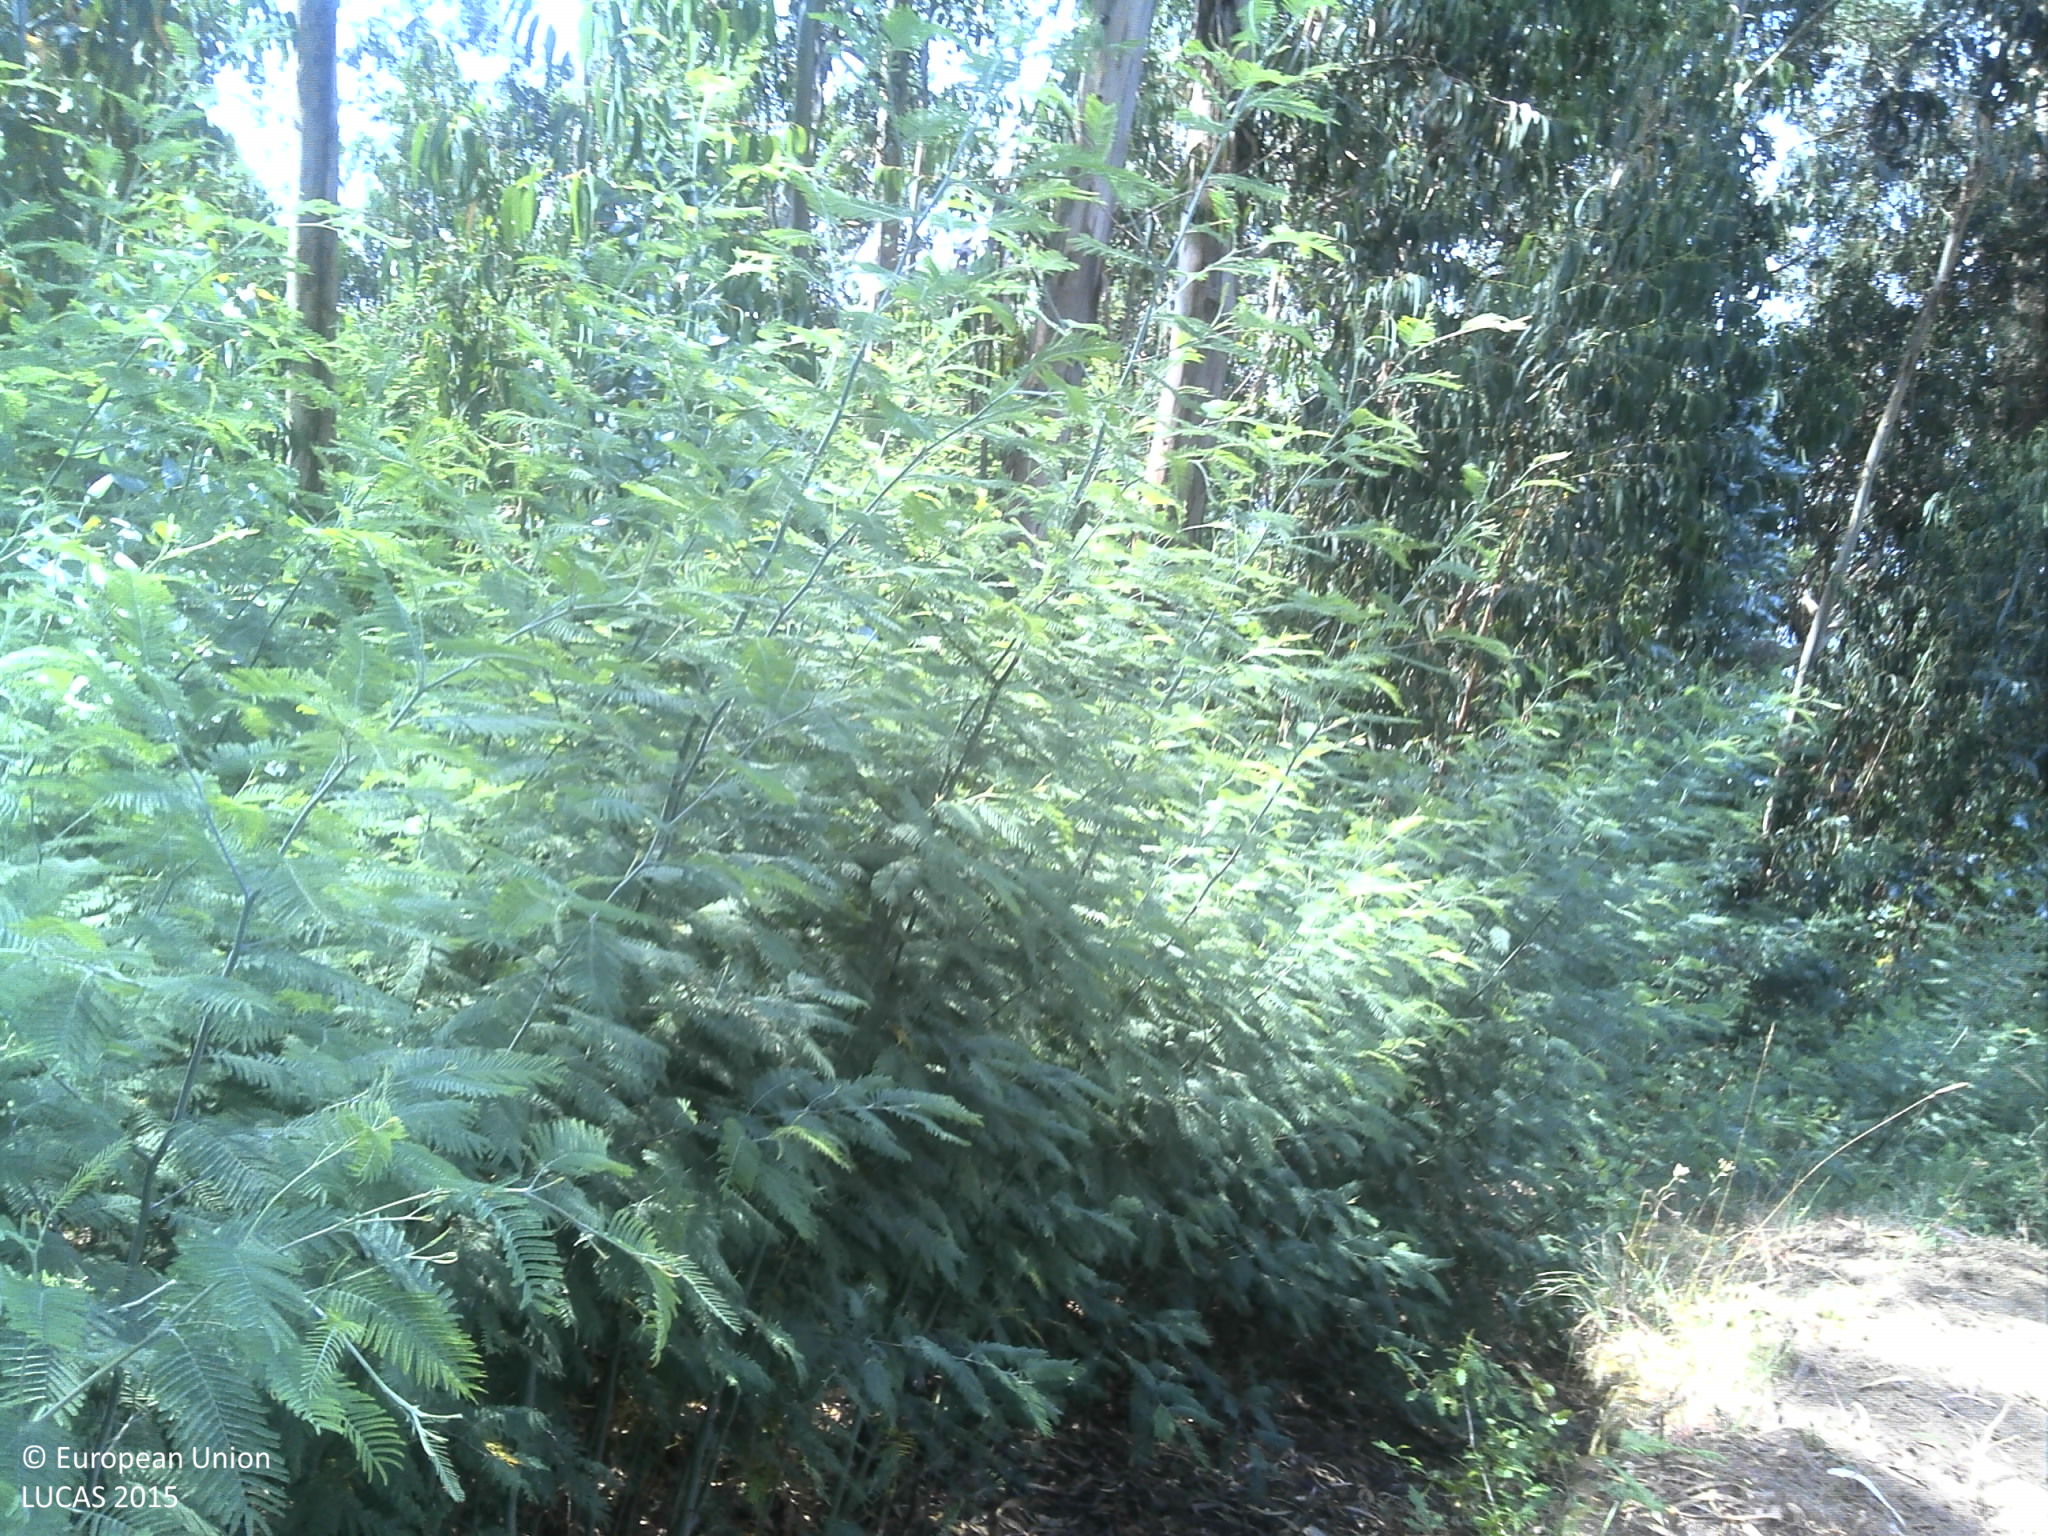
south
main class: Woodland
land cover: Broadleaved woodland
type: exotic forest
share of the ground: > 75 %
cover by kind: broadleaved forest trees 85 %, shrubs 10 %, unconsolidated bare surface 5 %
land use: Forestry
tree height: > 5 m
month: June
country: PT
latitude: 41.1252
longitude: -8.1605
